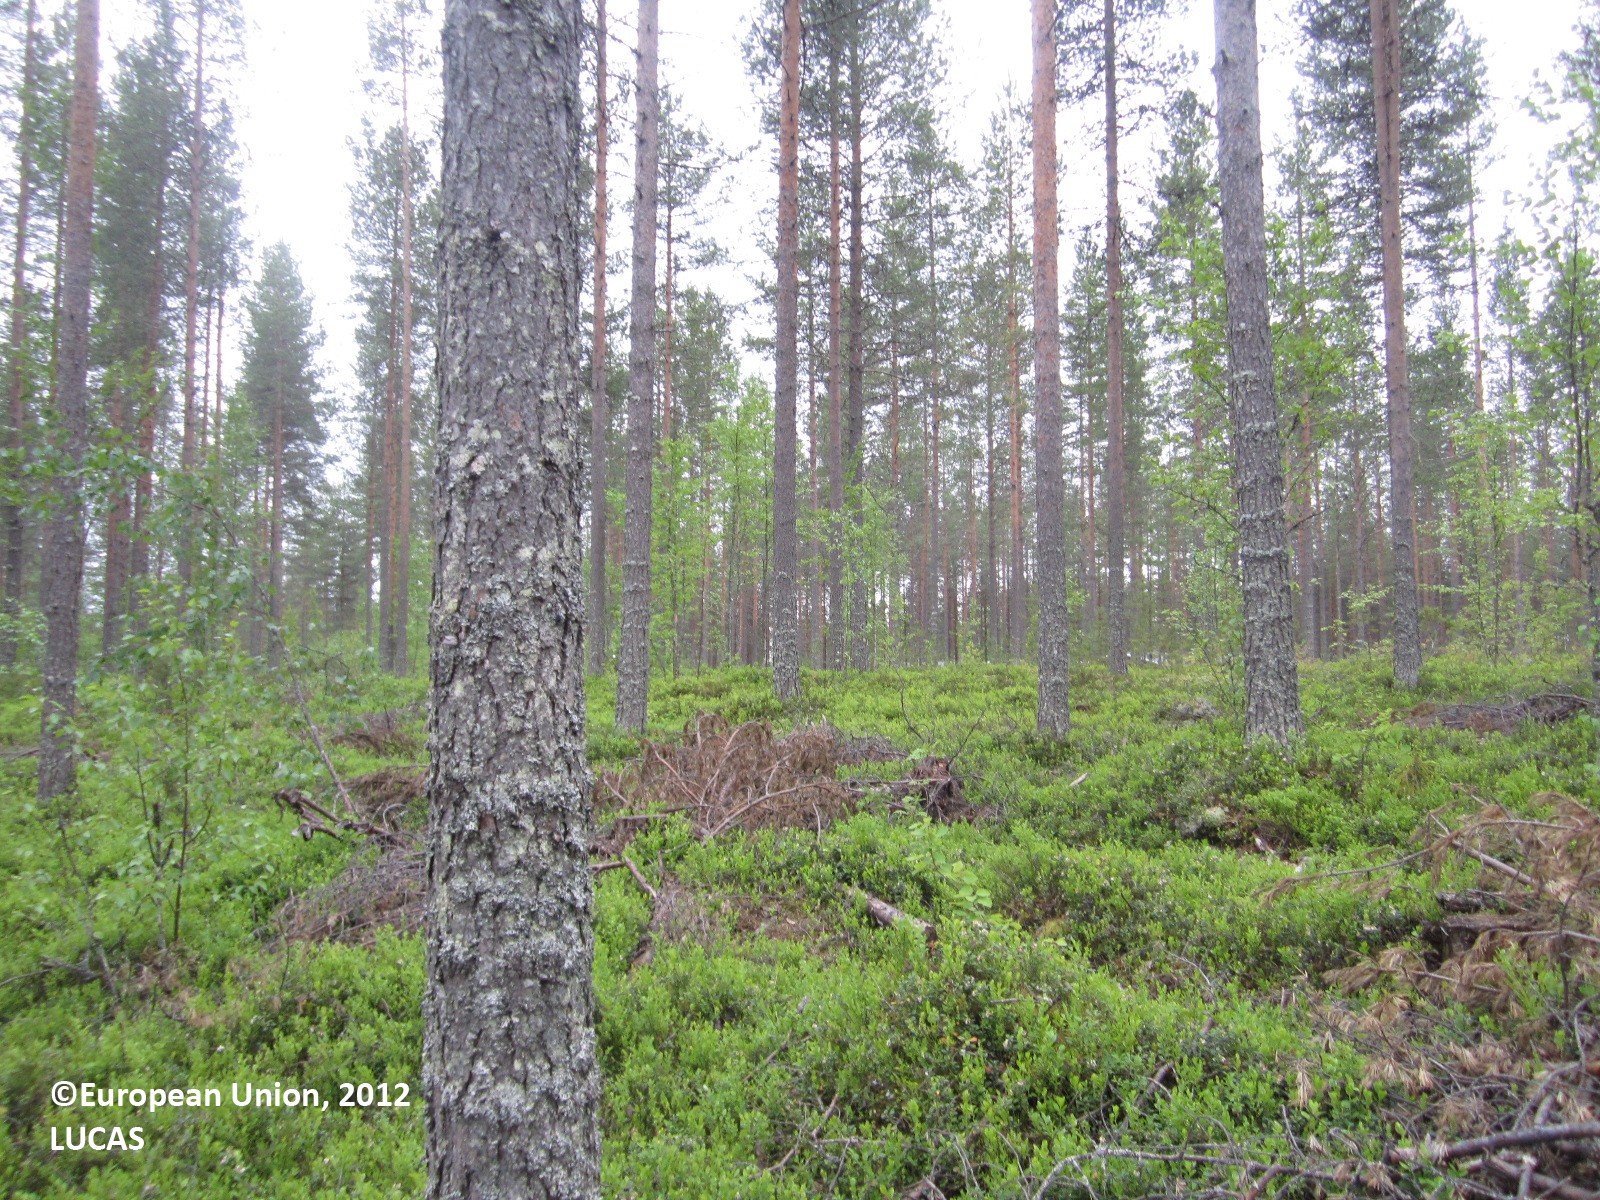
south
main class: Woodland
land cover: Pine dominated coniferous woodland
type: boreal forest
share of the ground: 50 - 75 %
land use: Forestry
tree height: > 5 m
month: June
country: FI
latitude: 64.4580
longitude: 29.5258
